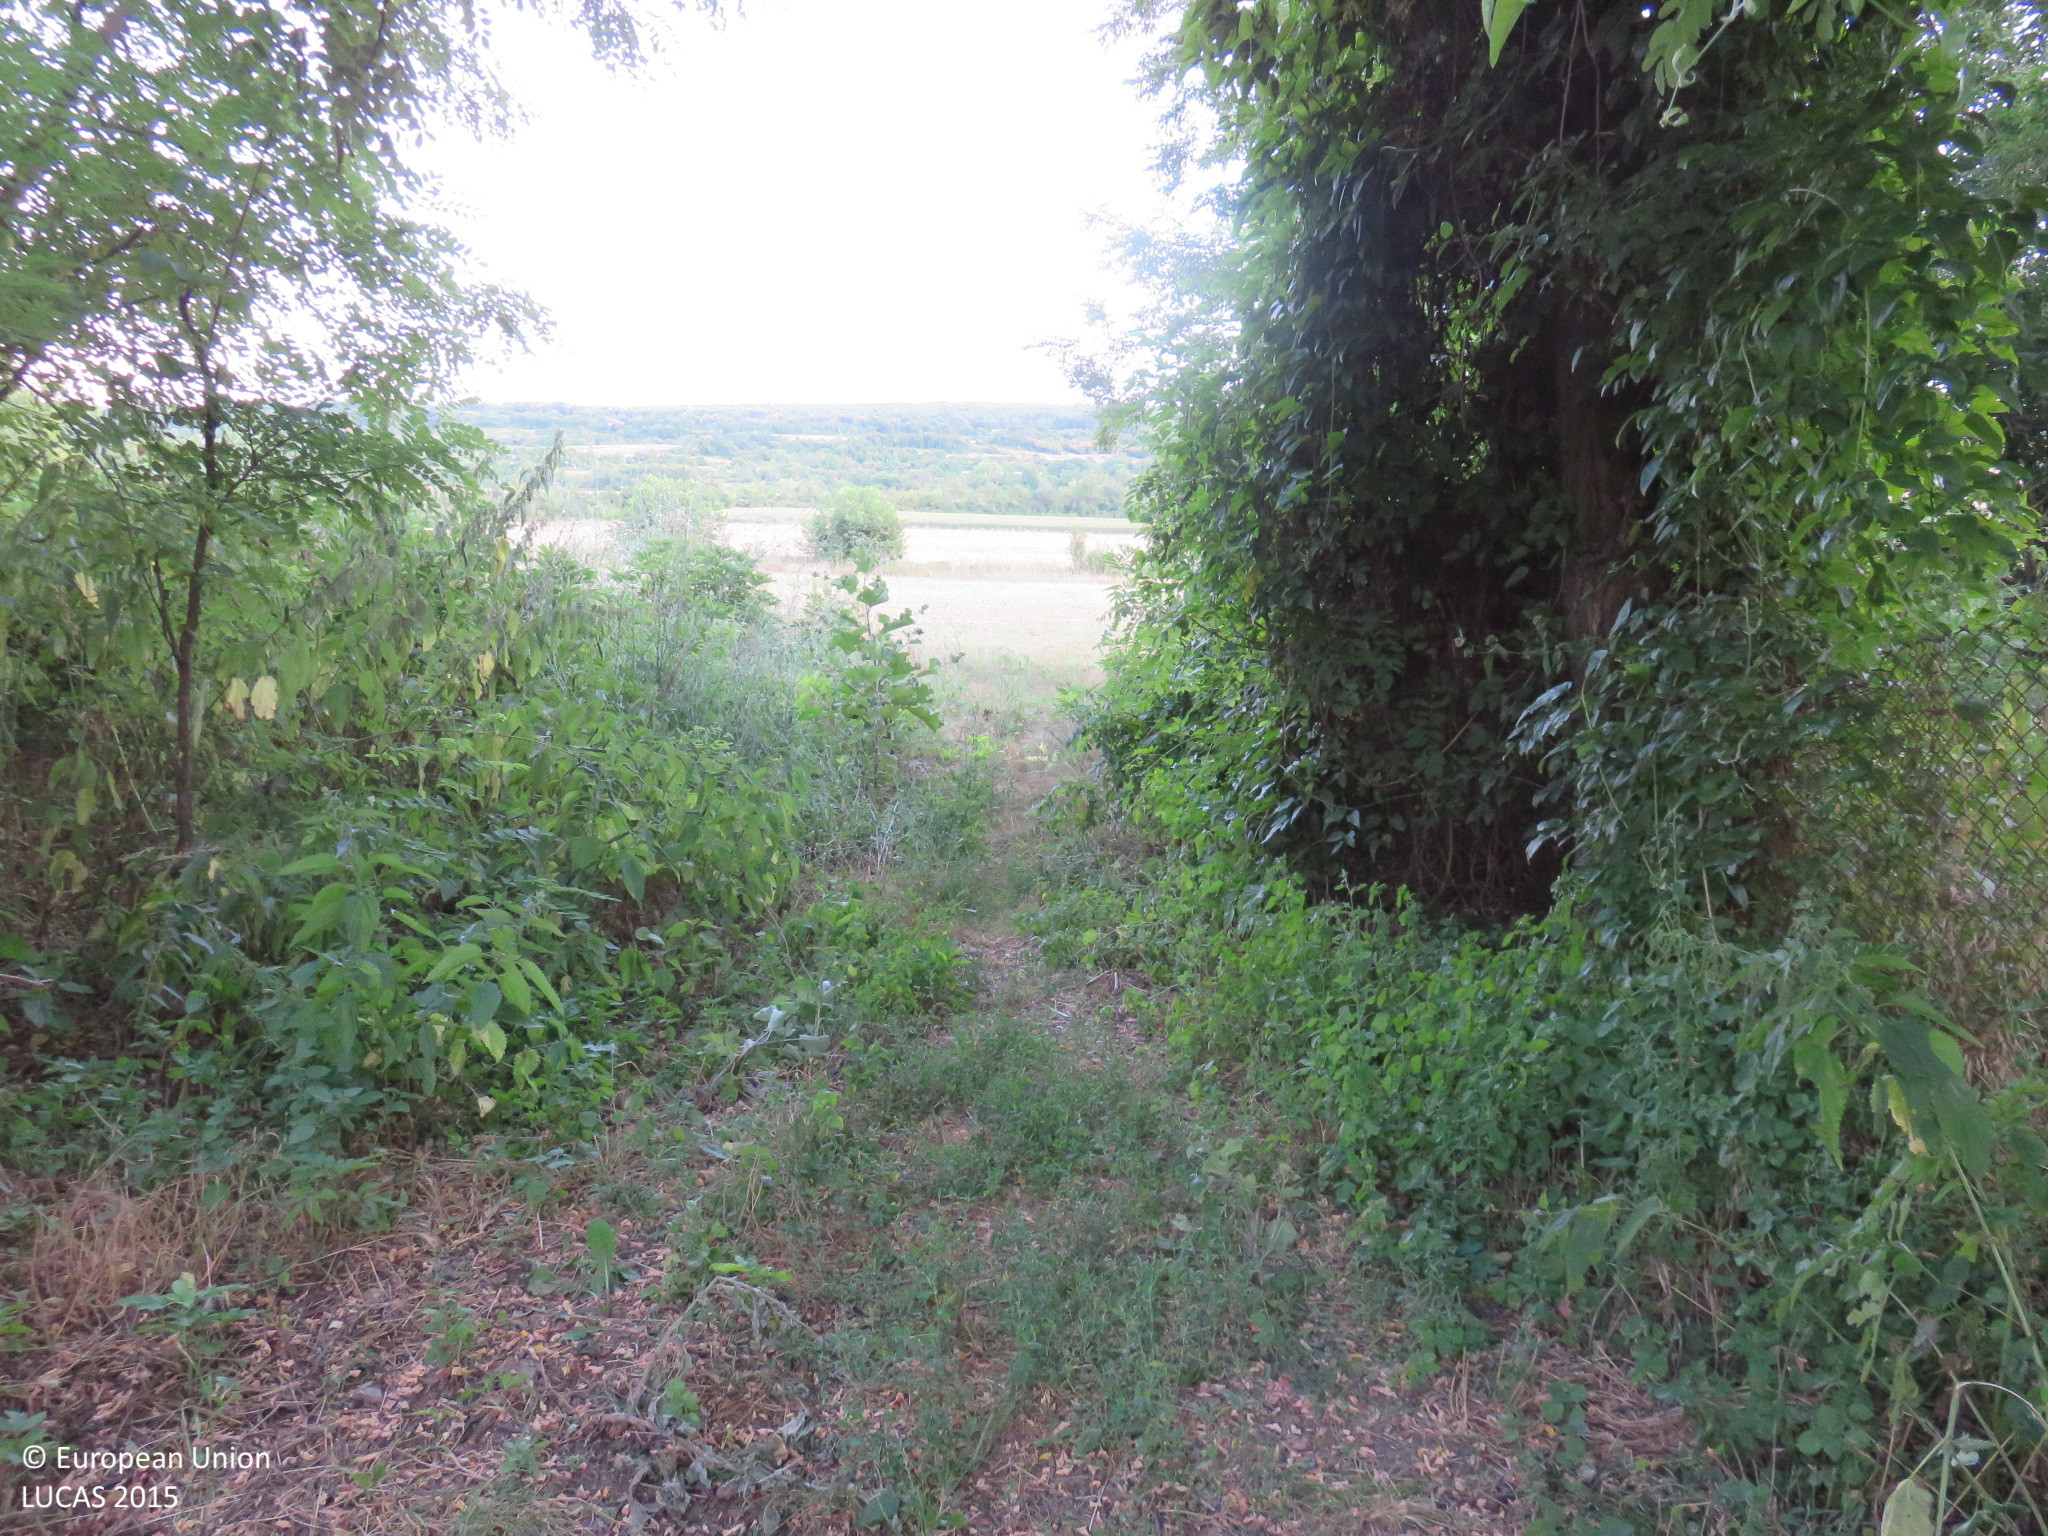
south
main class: Woodland
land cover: Broadleaved woodland
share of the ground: 25 - 50 %
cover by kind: herbaceous plants 60 %, broadleaved forest trees 35 %, shrubs 5 %
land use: Residential
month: July
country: BG
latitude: 43.1308
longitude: 25.2038
